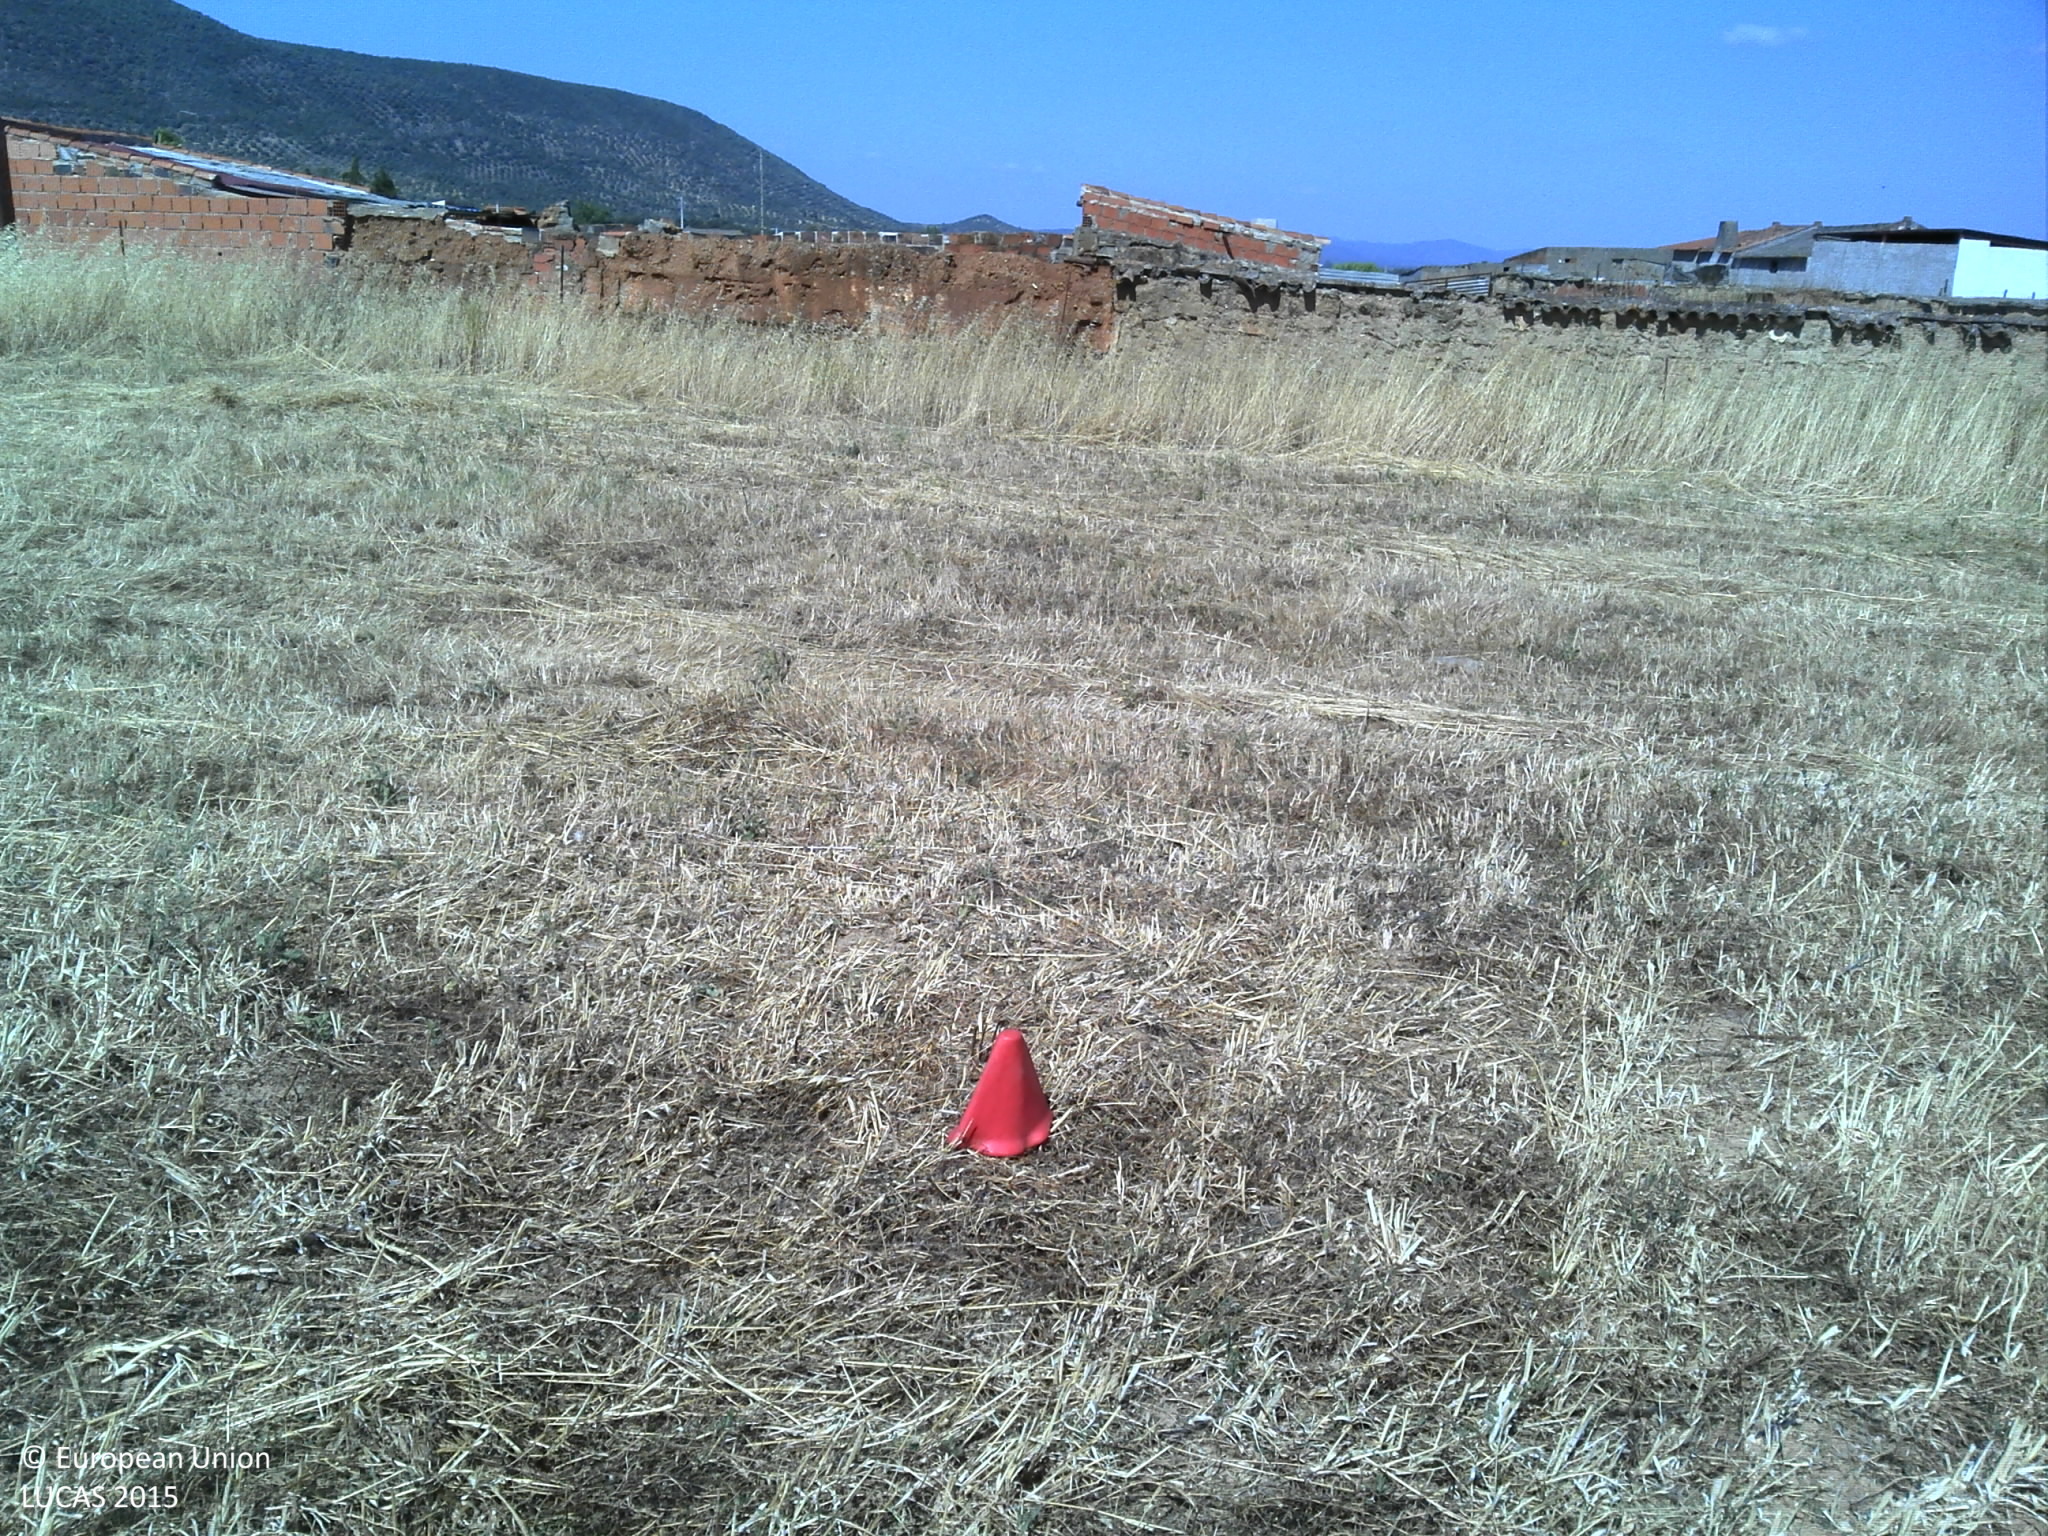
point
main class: Grassland
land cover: Grassland without tree/shrub cover
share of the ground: > 75 %
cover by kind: herbaceous plants 90 %, unconsolidated bare surface 10 %
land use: Agriculture (excluding fallow land and kitchen gardens)
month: June
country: PT
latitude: 37.9420
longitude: -7.2983
